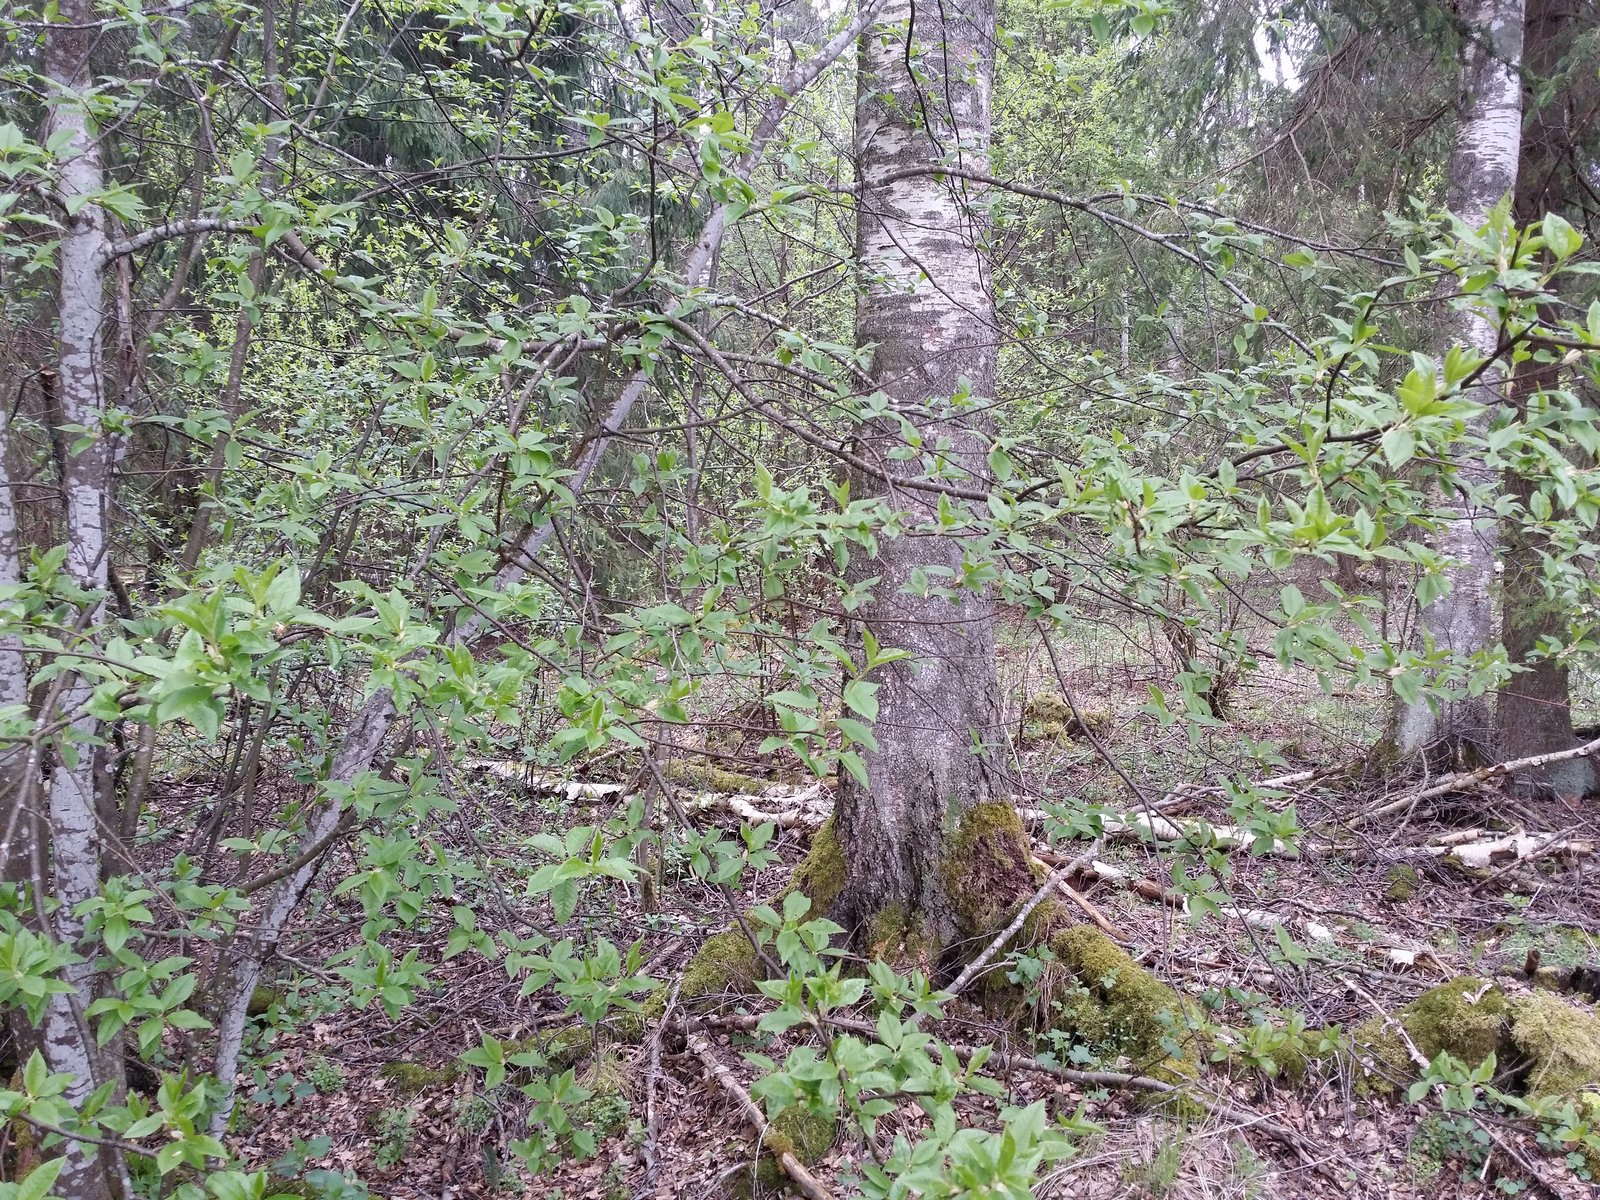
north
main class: Woodland
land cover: Spruce dominated mixed woodland
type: hemiboreal forest and nemoral coniferous forest and mixed broadleaved-coniferous forest
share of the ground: > 75 %
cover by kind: coniferous forest trees 40 %, broadleaved forest trees 40 %, lichens and mosses 20 %
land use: Forestry
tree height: > 5 m
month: May
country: LV
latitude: 57.5355
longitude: 26.0822
